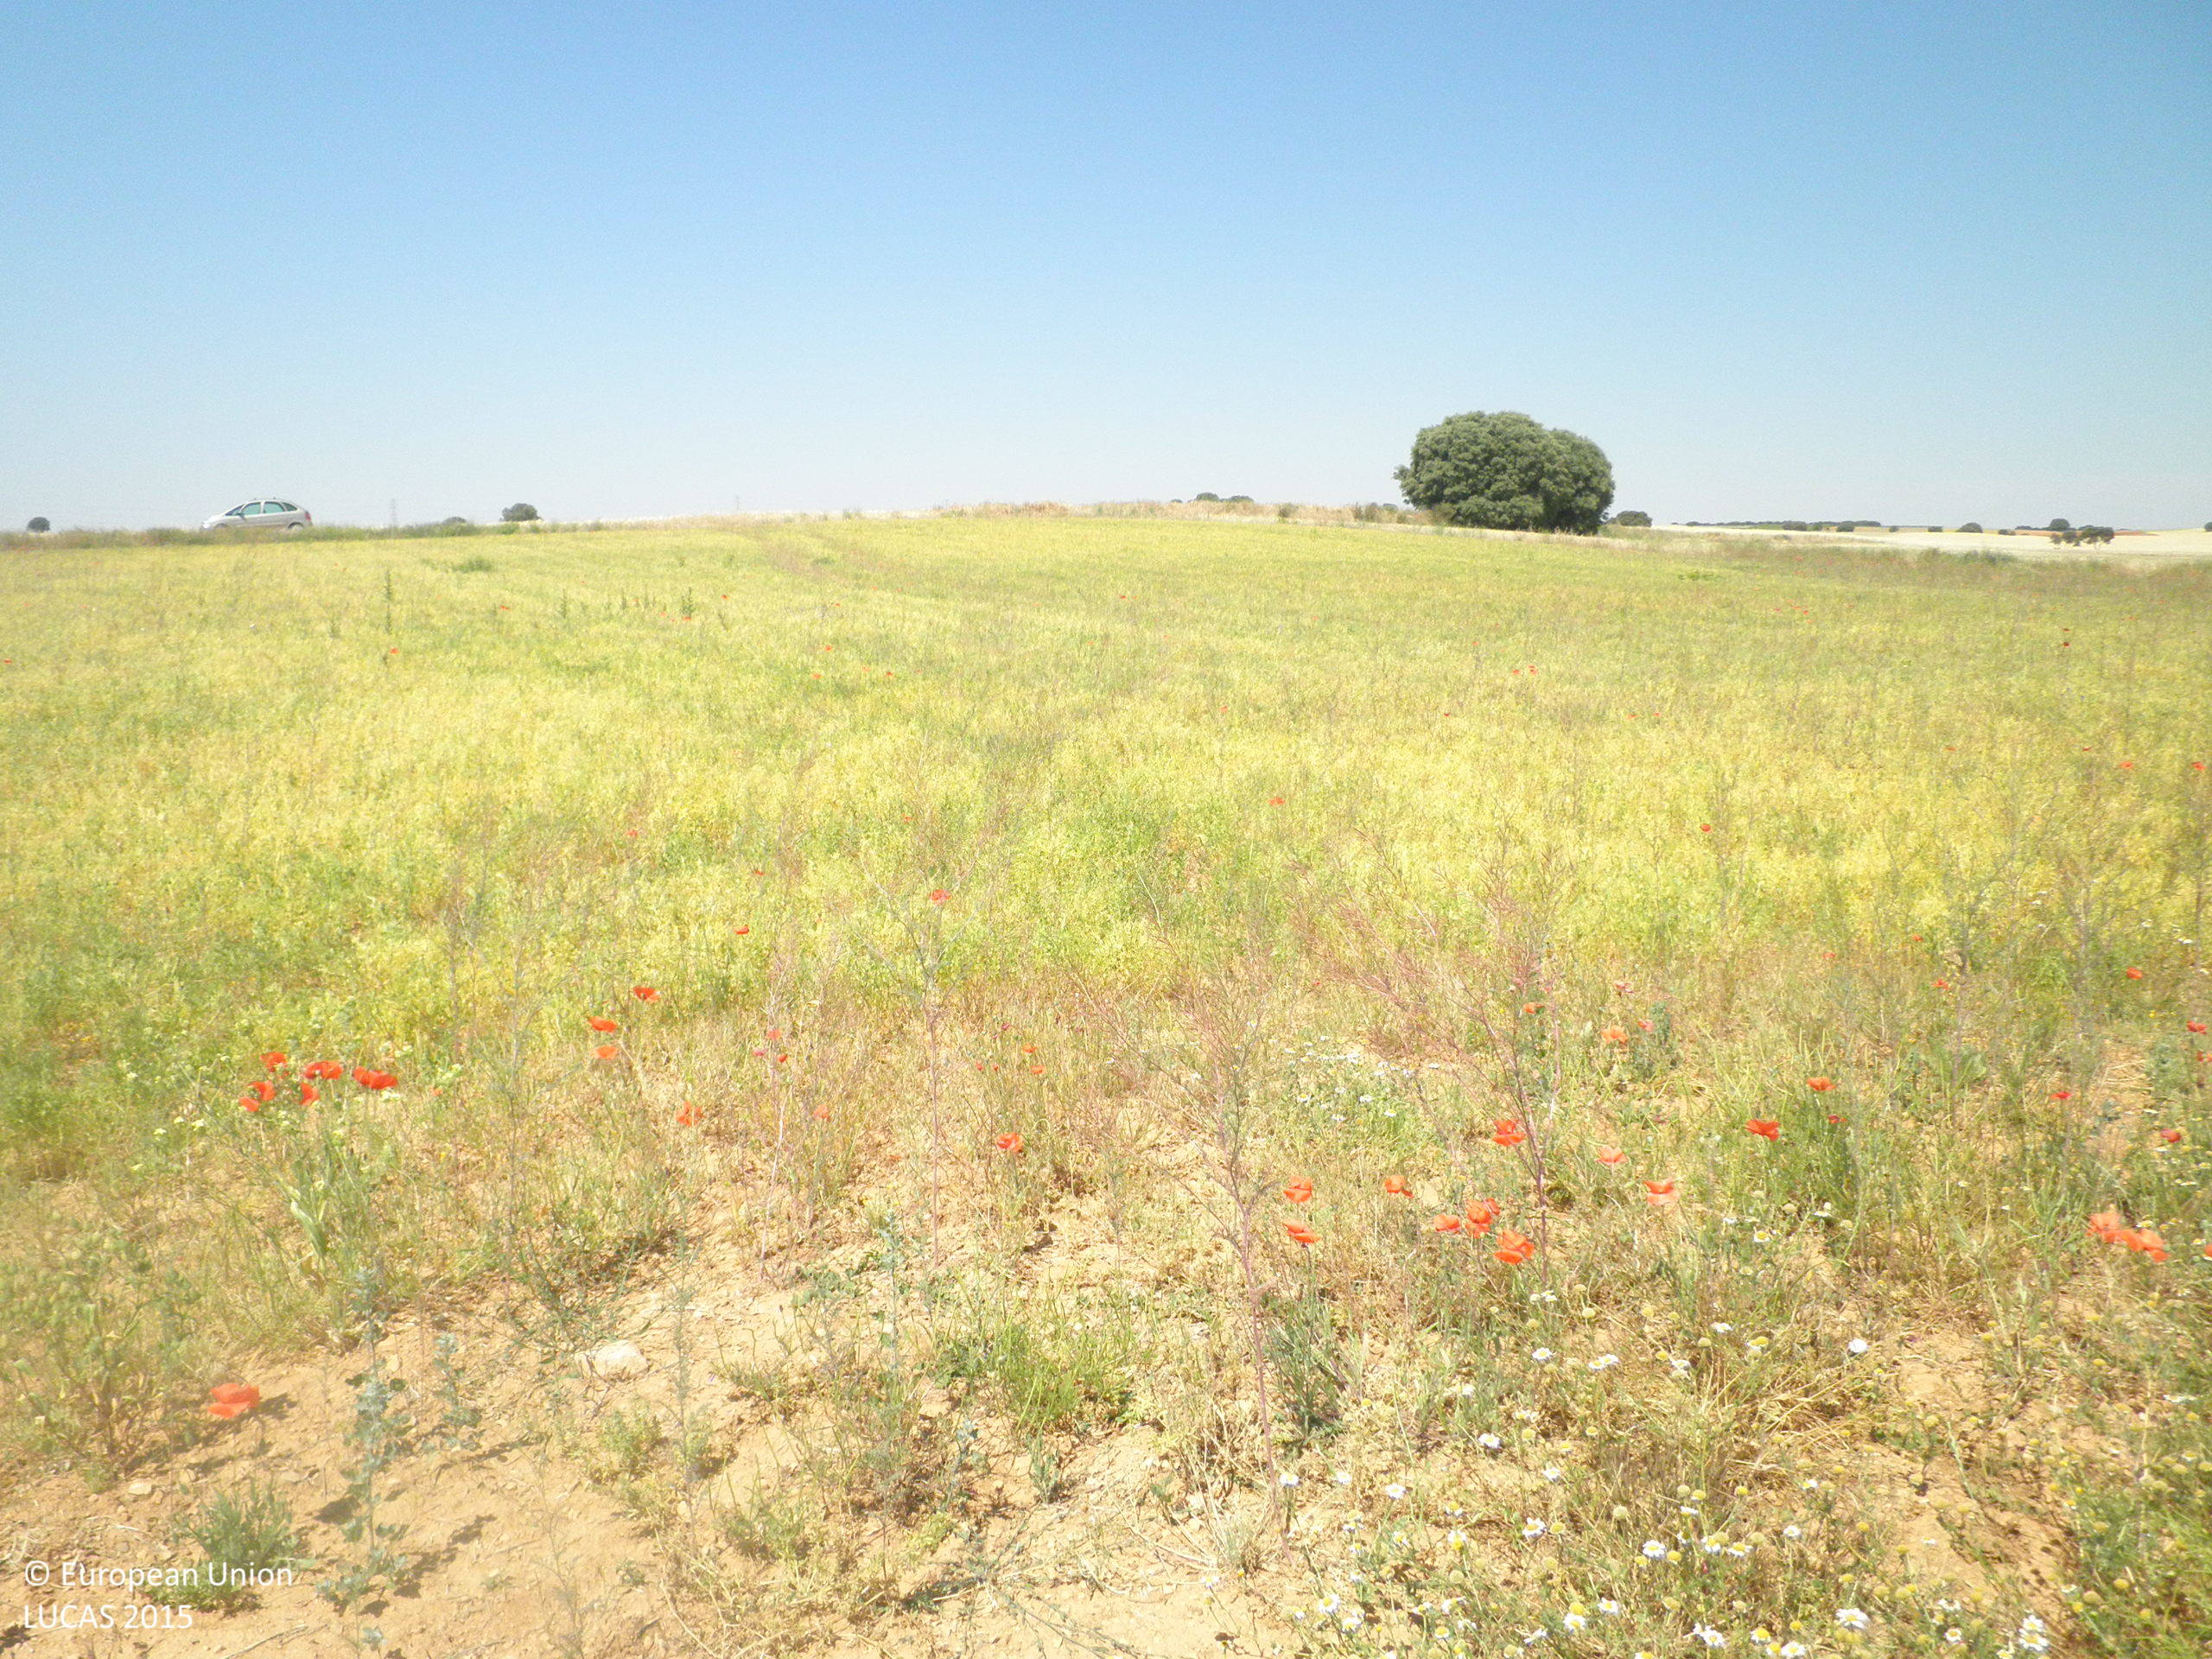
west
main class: Woodland
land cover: Broadleaved woodland
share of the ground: > 75 %
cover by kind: herbaceous plants 60 %, unconsolidated bare surface 25 %, broadleaved forest trees 15 %
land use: Semi-natural and natural areas not in use
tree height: < 5 m
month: June
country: ES
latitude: 39.5145
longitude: -1.8123
